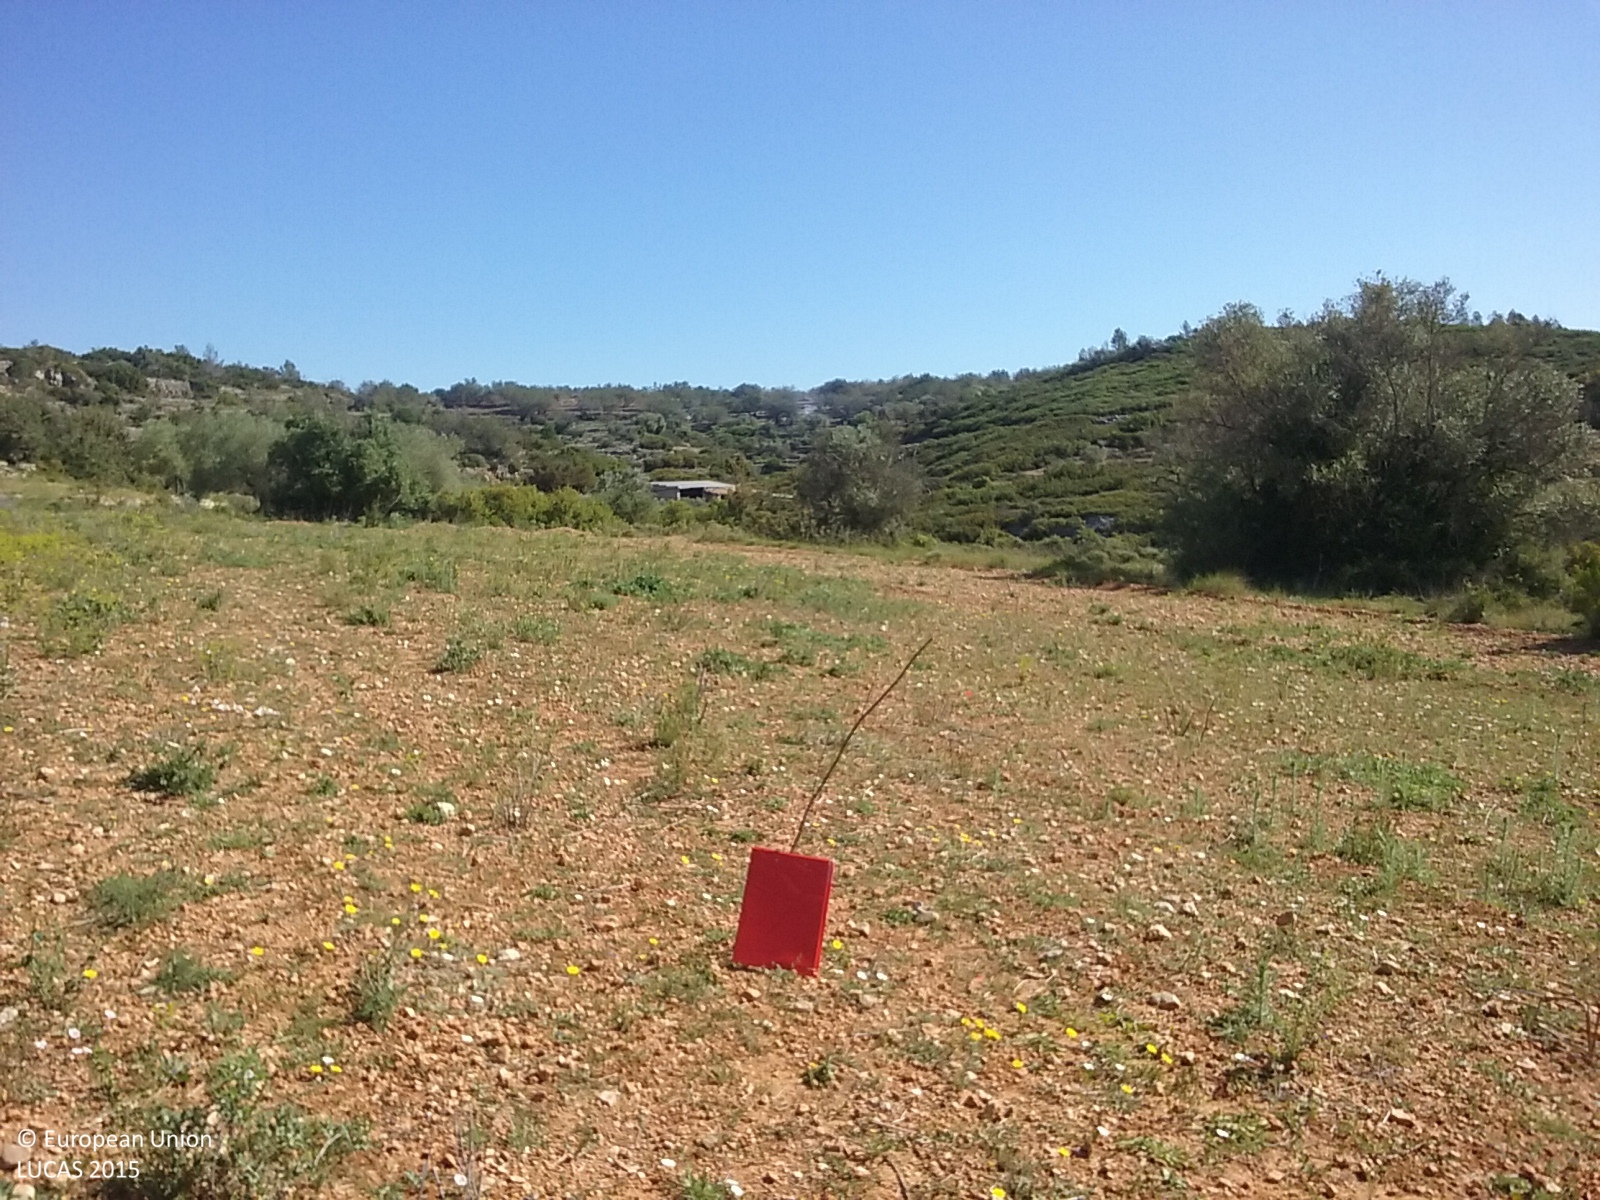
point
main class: Grassland
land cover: Spontaneously vegetated surfaces
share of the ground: 50 - 75 %
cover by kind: herbaceous plants 70 %, unconsolidated bare surface 30 %
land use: Fallow land
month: May
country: ES
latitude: 40.4382
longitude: 0.2702
